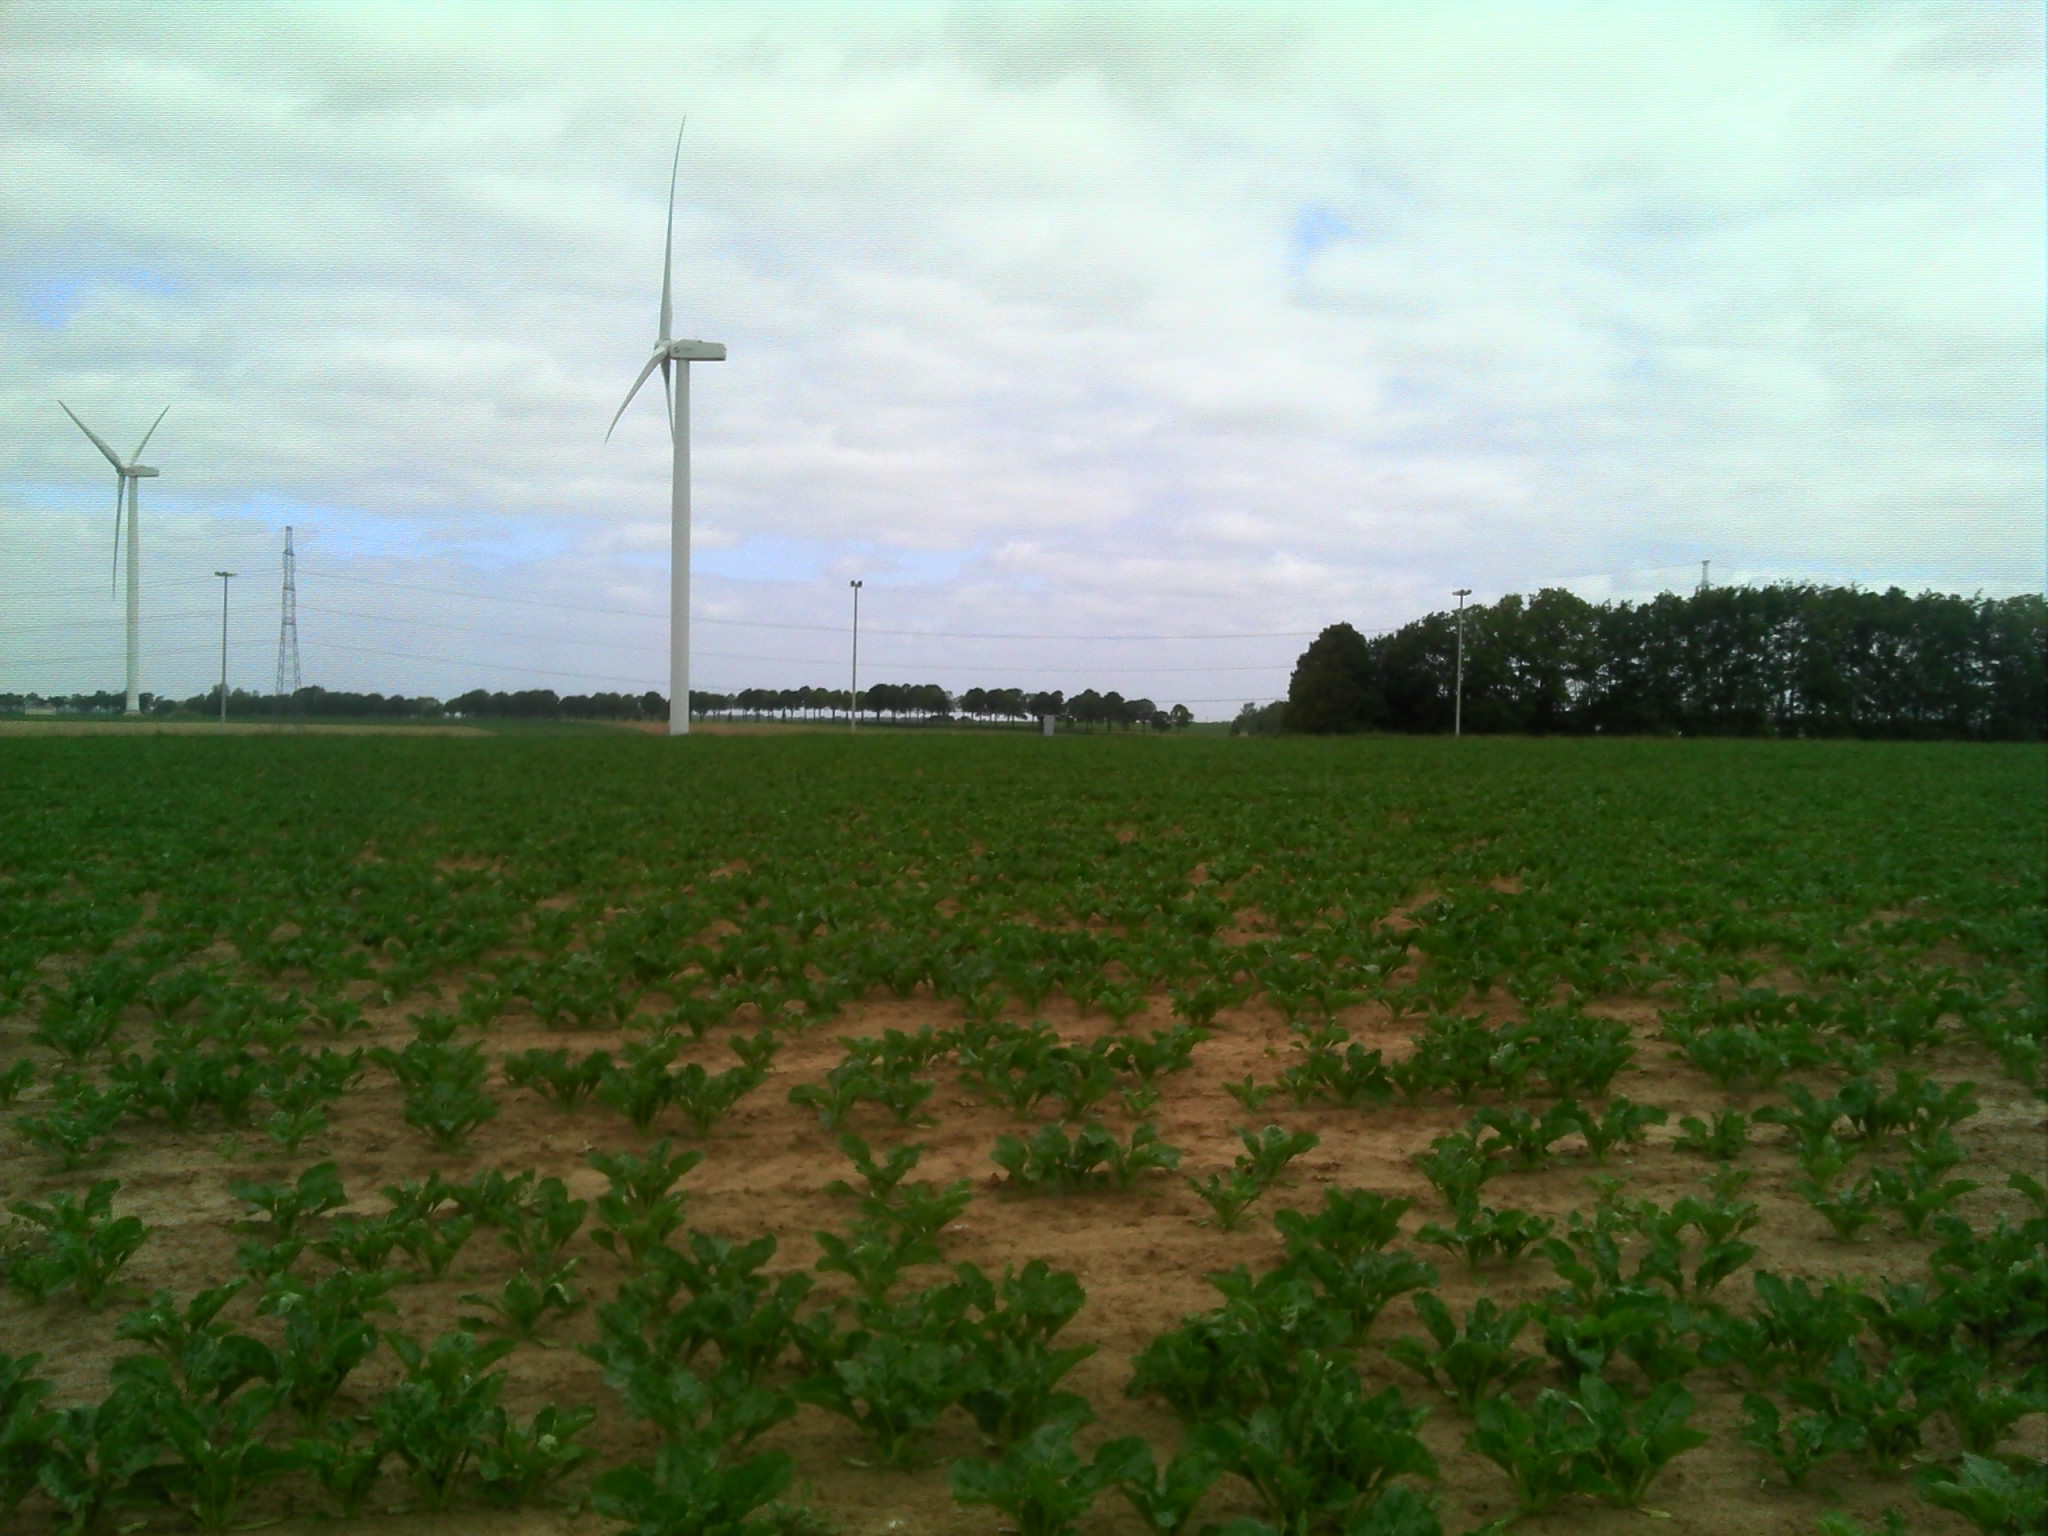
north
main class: Cropland
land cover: Sugar beet
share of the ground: 25 - 50 %
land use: Agriculture (excluding fallow land and kitchen gardens)
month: June
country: BE
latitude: 50.4940
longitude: 4.7102
